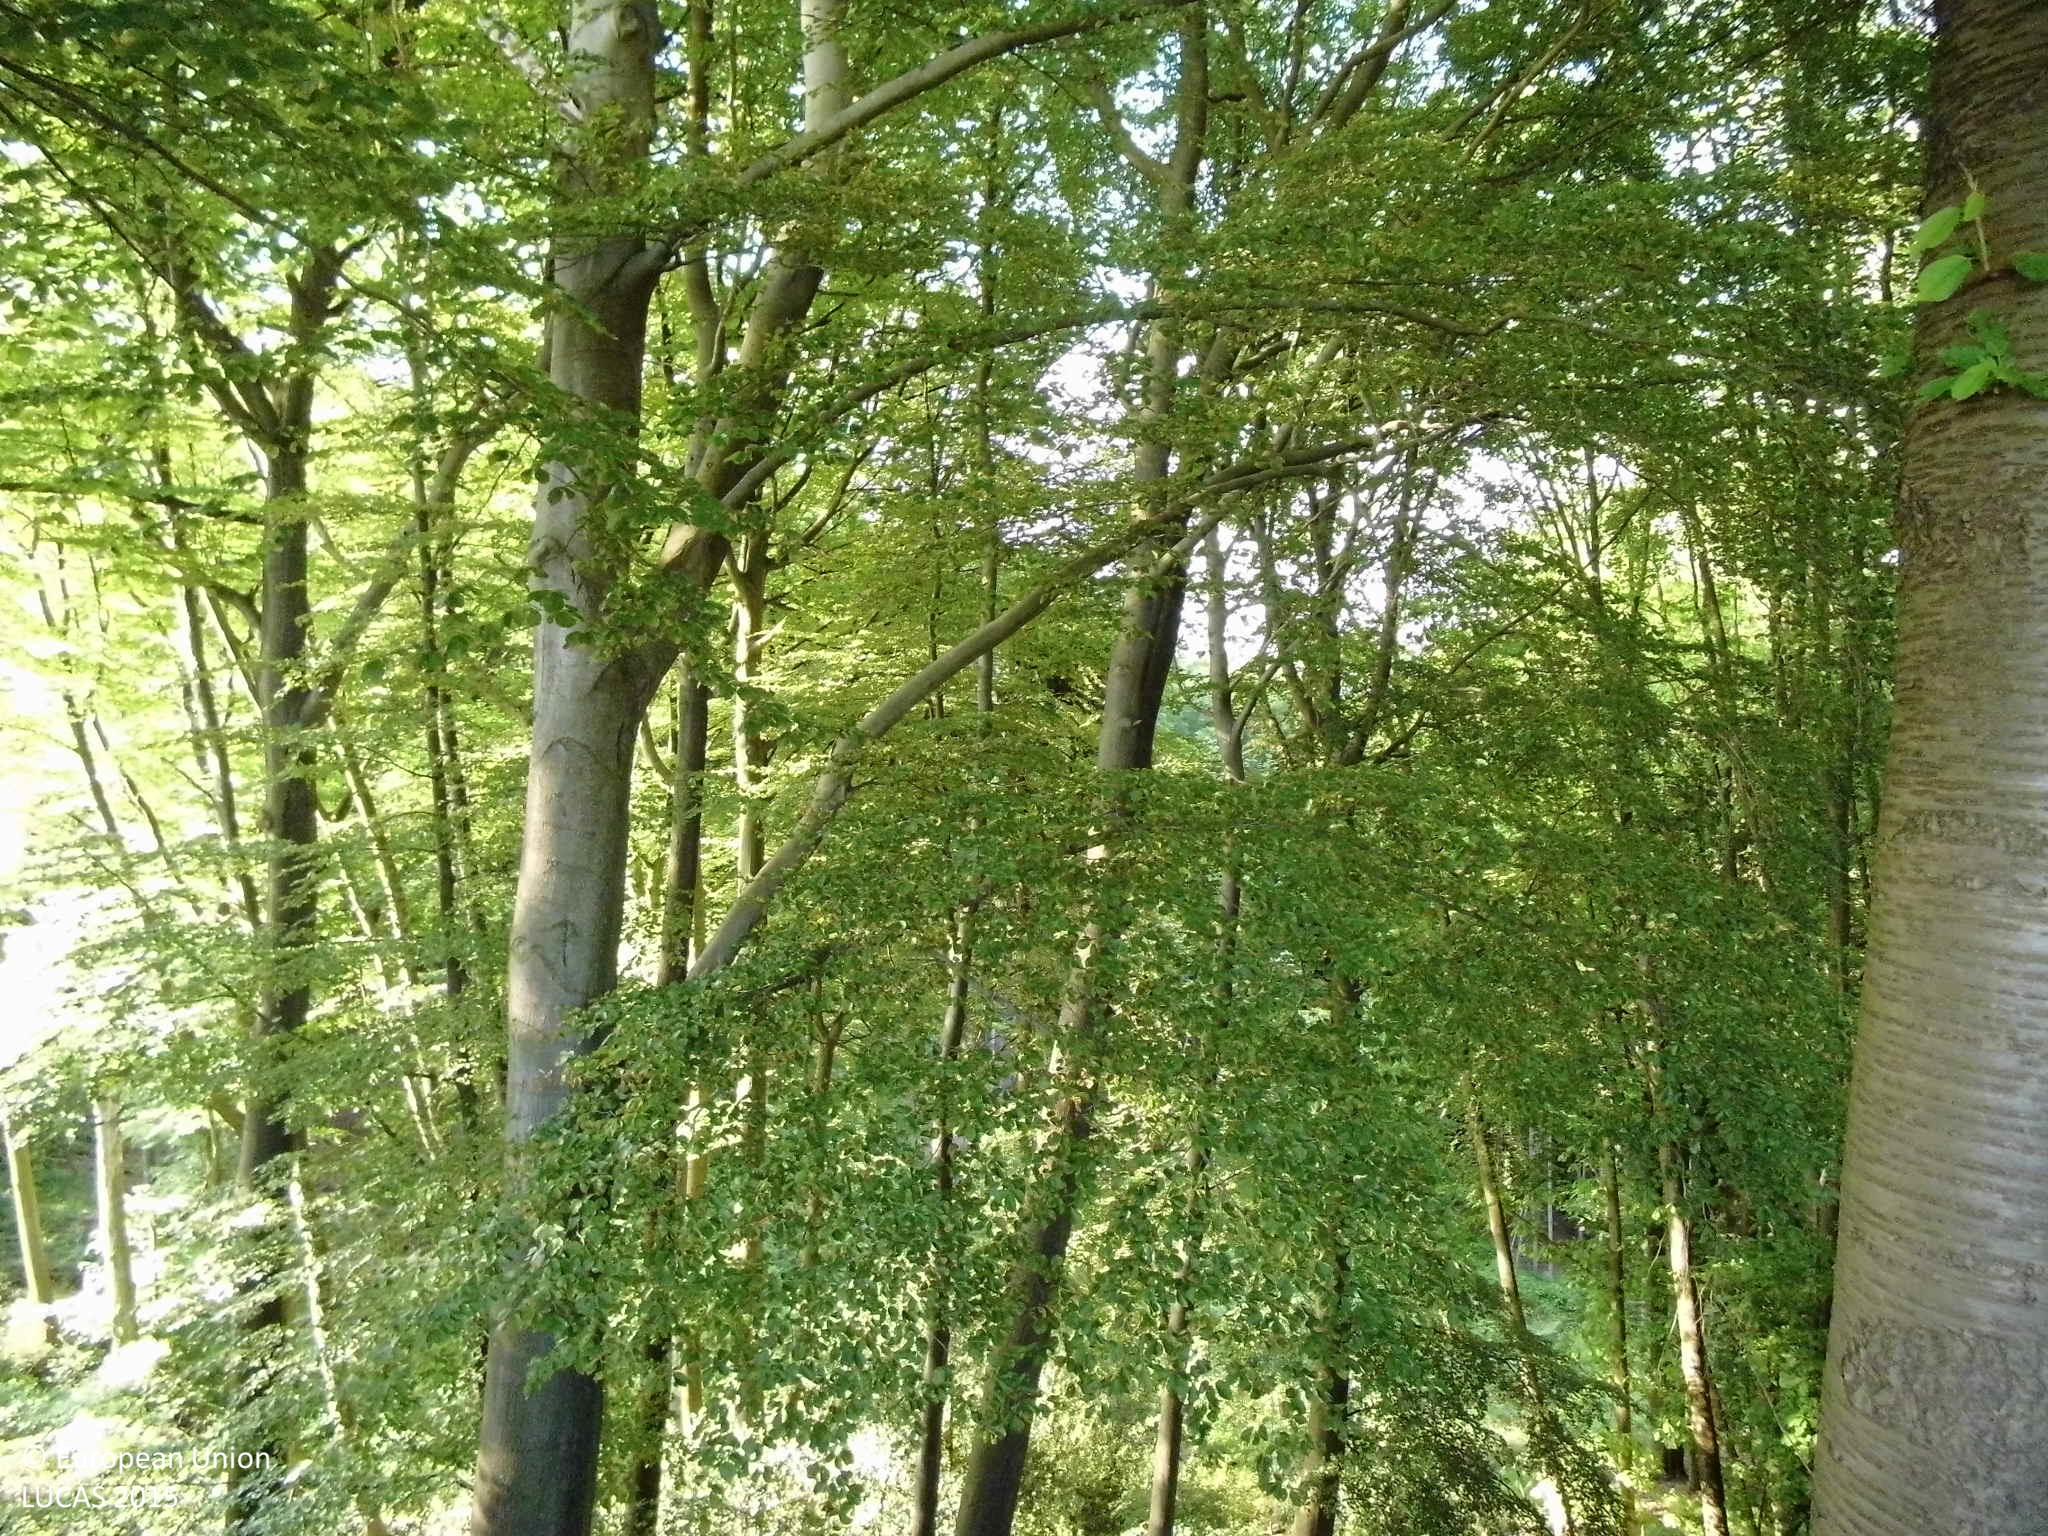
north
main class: Woodland
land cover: Broadleaved woodland
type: mesophytic deciduous forest
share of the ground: > 75 %
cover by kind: broadleaved forest trees 75 %, coniferous forest trees 10 %, shrubs 5 %, herbaceous plants 5 %, unconsolidated bare surface 5 %
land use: Forestry
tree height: > 5 m
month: May
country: DE
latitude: 50.7689
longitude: 7.5189
